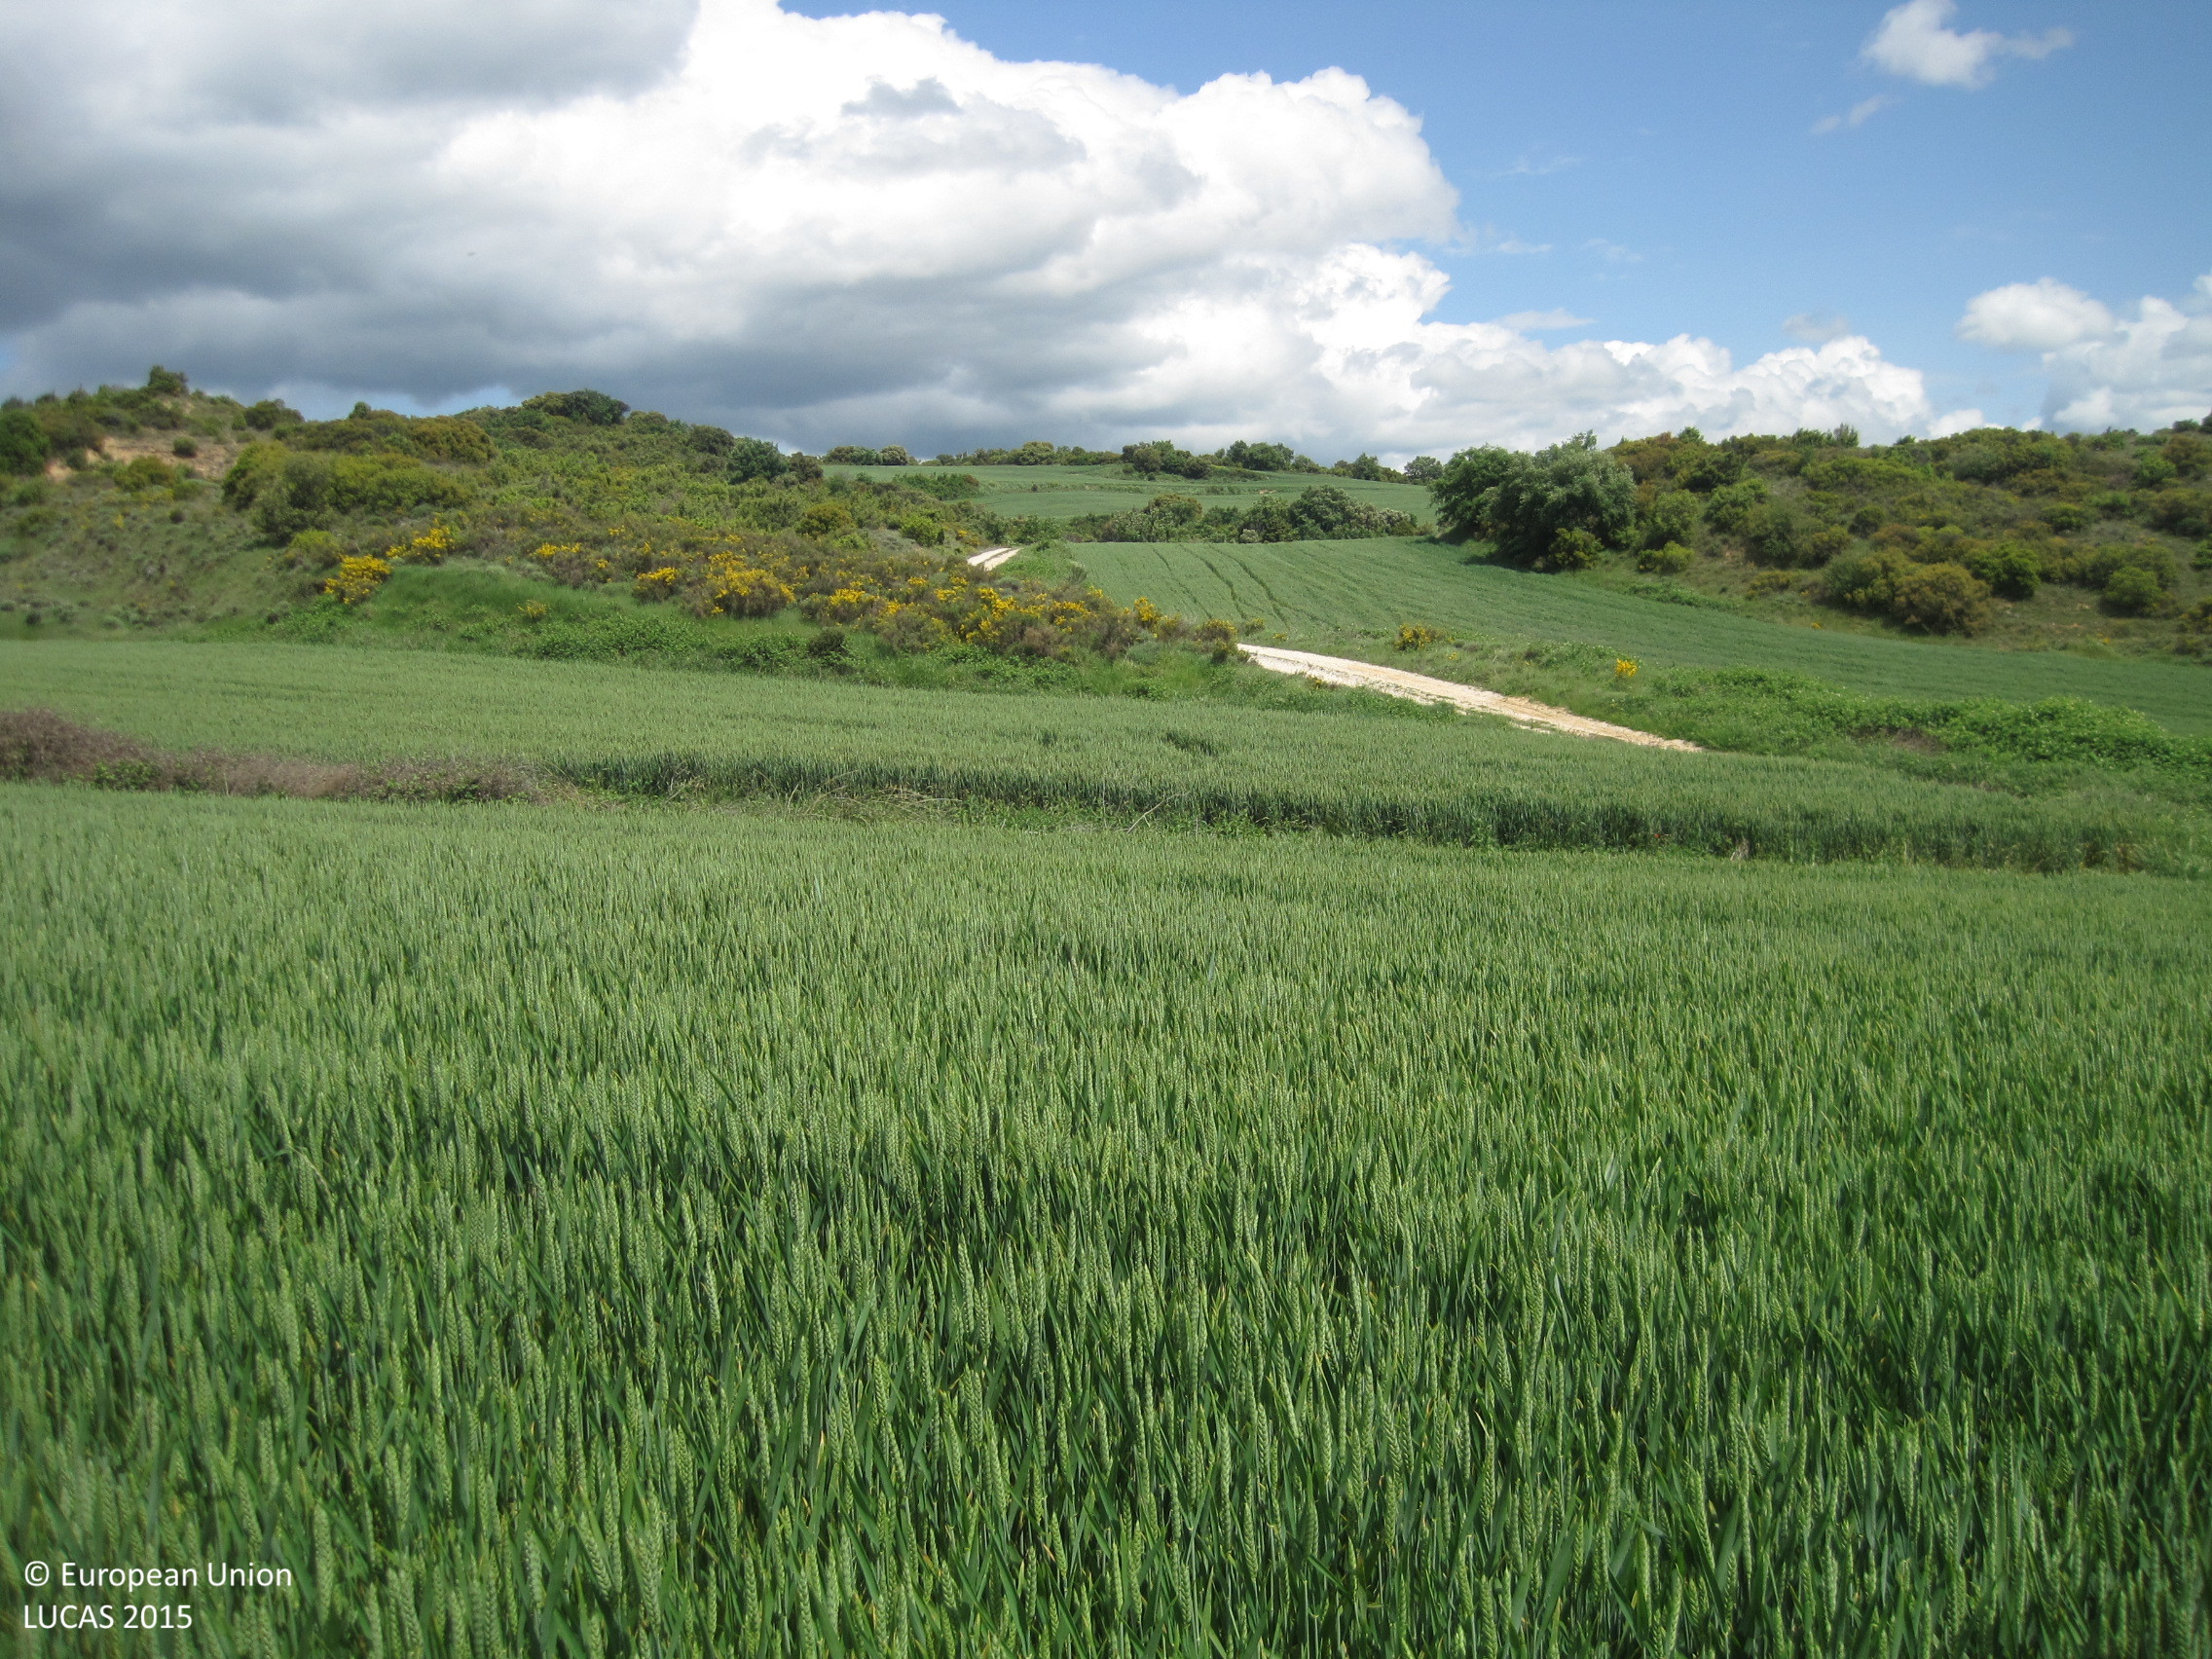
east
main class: Woodland
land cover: Broadleaved woodland
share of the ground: 25 - 50 %
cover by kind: shrubs 70 %, broadleaved forest trees 30 %
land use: Semi-natural and natural areas not in use
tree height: < 5 m
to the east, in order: Broadleaved woodland; Common wheat; Grass margins; Ditches and canals; Grass margins; Common wheat; Shrubland without tree cover; Grass margins; Tracks; Grass margins; Common wheat; Broadleaved woodland; Rape and turnip rape
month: May
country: ES
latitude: 42.7001
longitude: -1.7215
